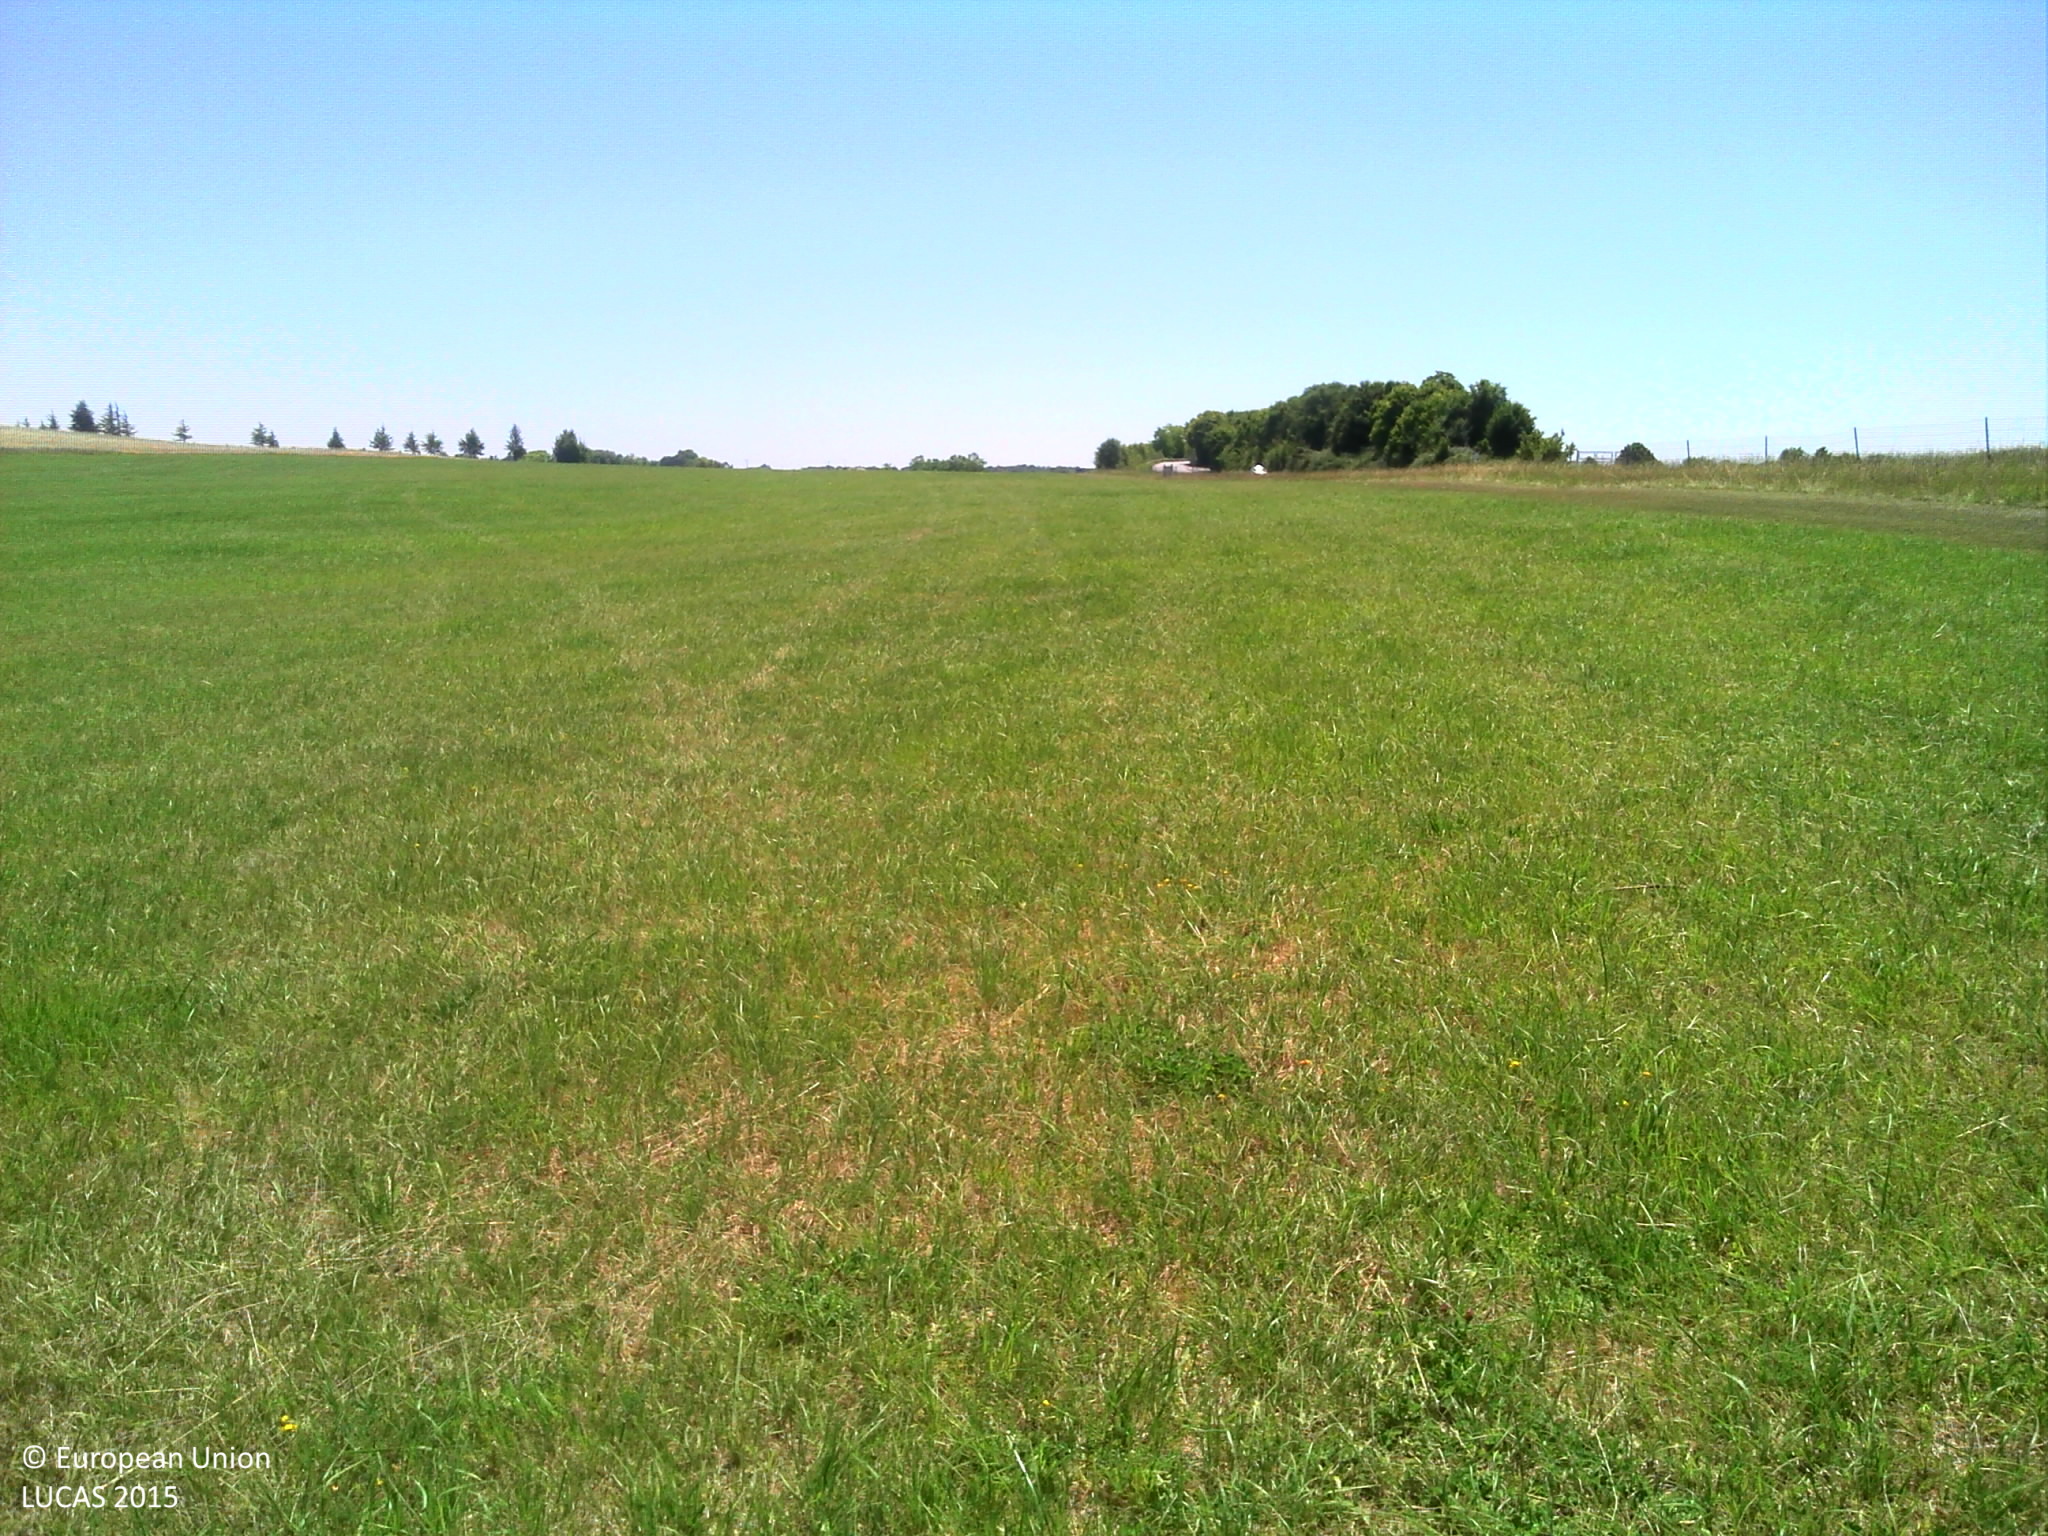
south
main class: Grassland
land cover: Grassland without tree/shrub cover
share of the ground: > 75 %
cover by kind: herbaceous plants 100 %
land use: Air transport
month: June
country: FR
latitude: 45.6915
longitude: -0.6437
